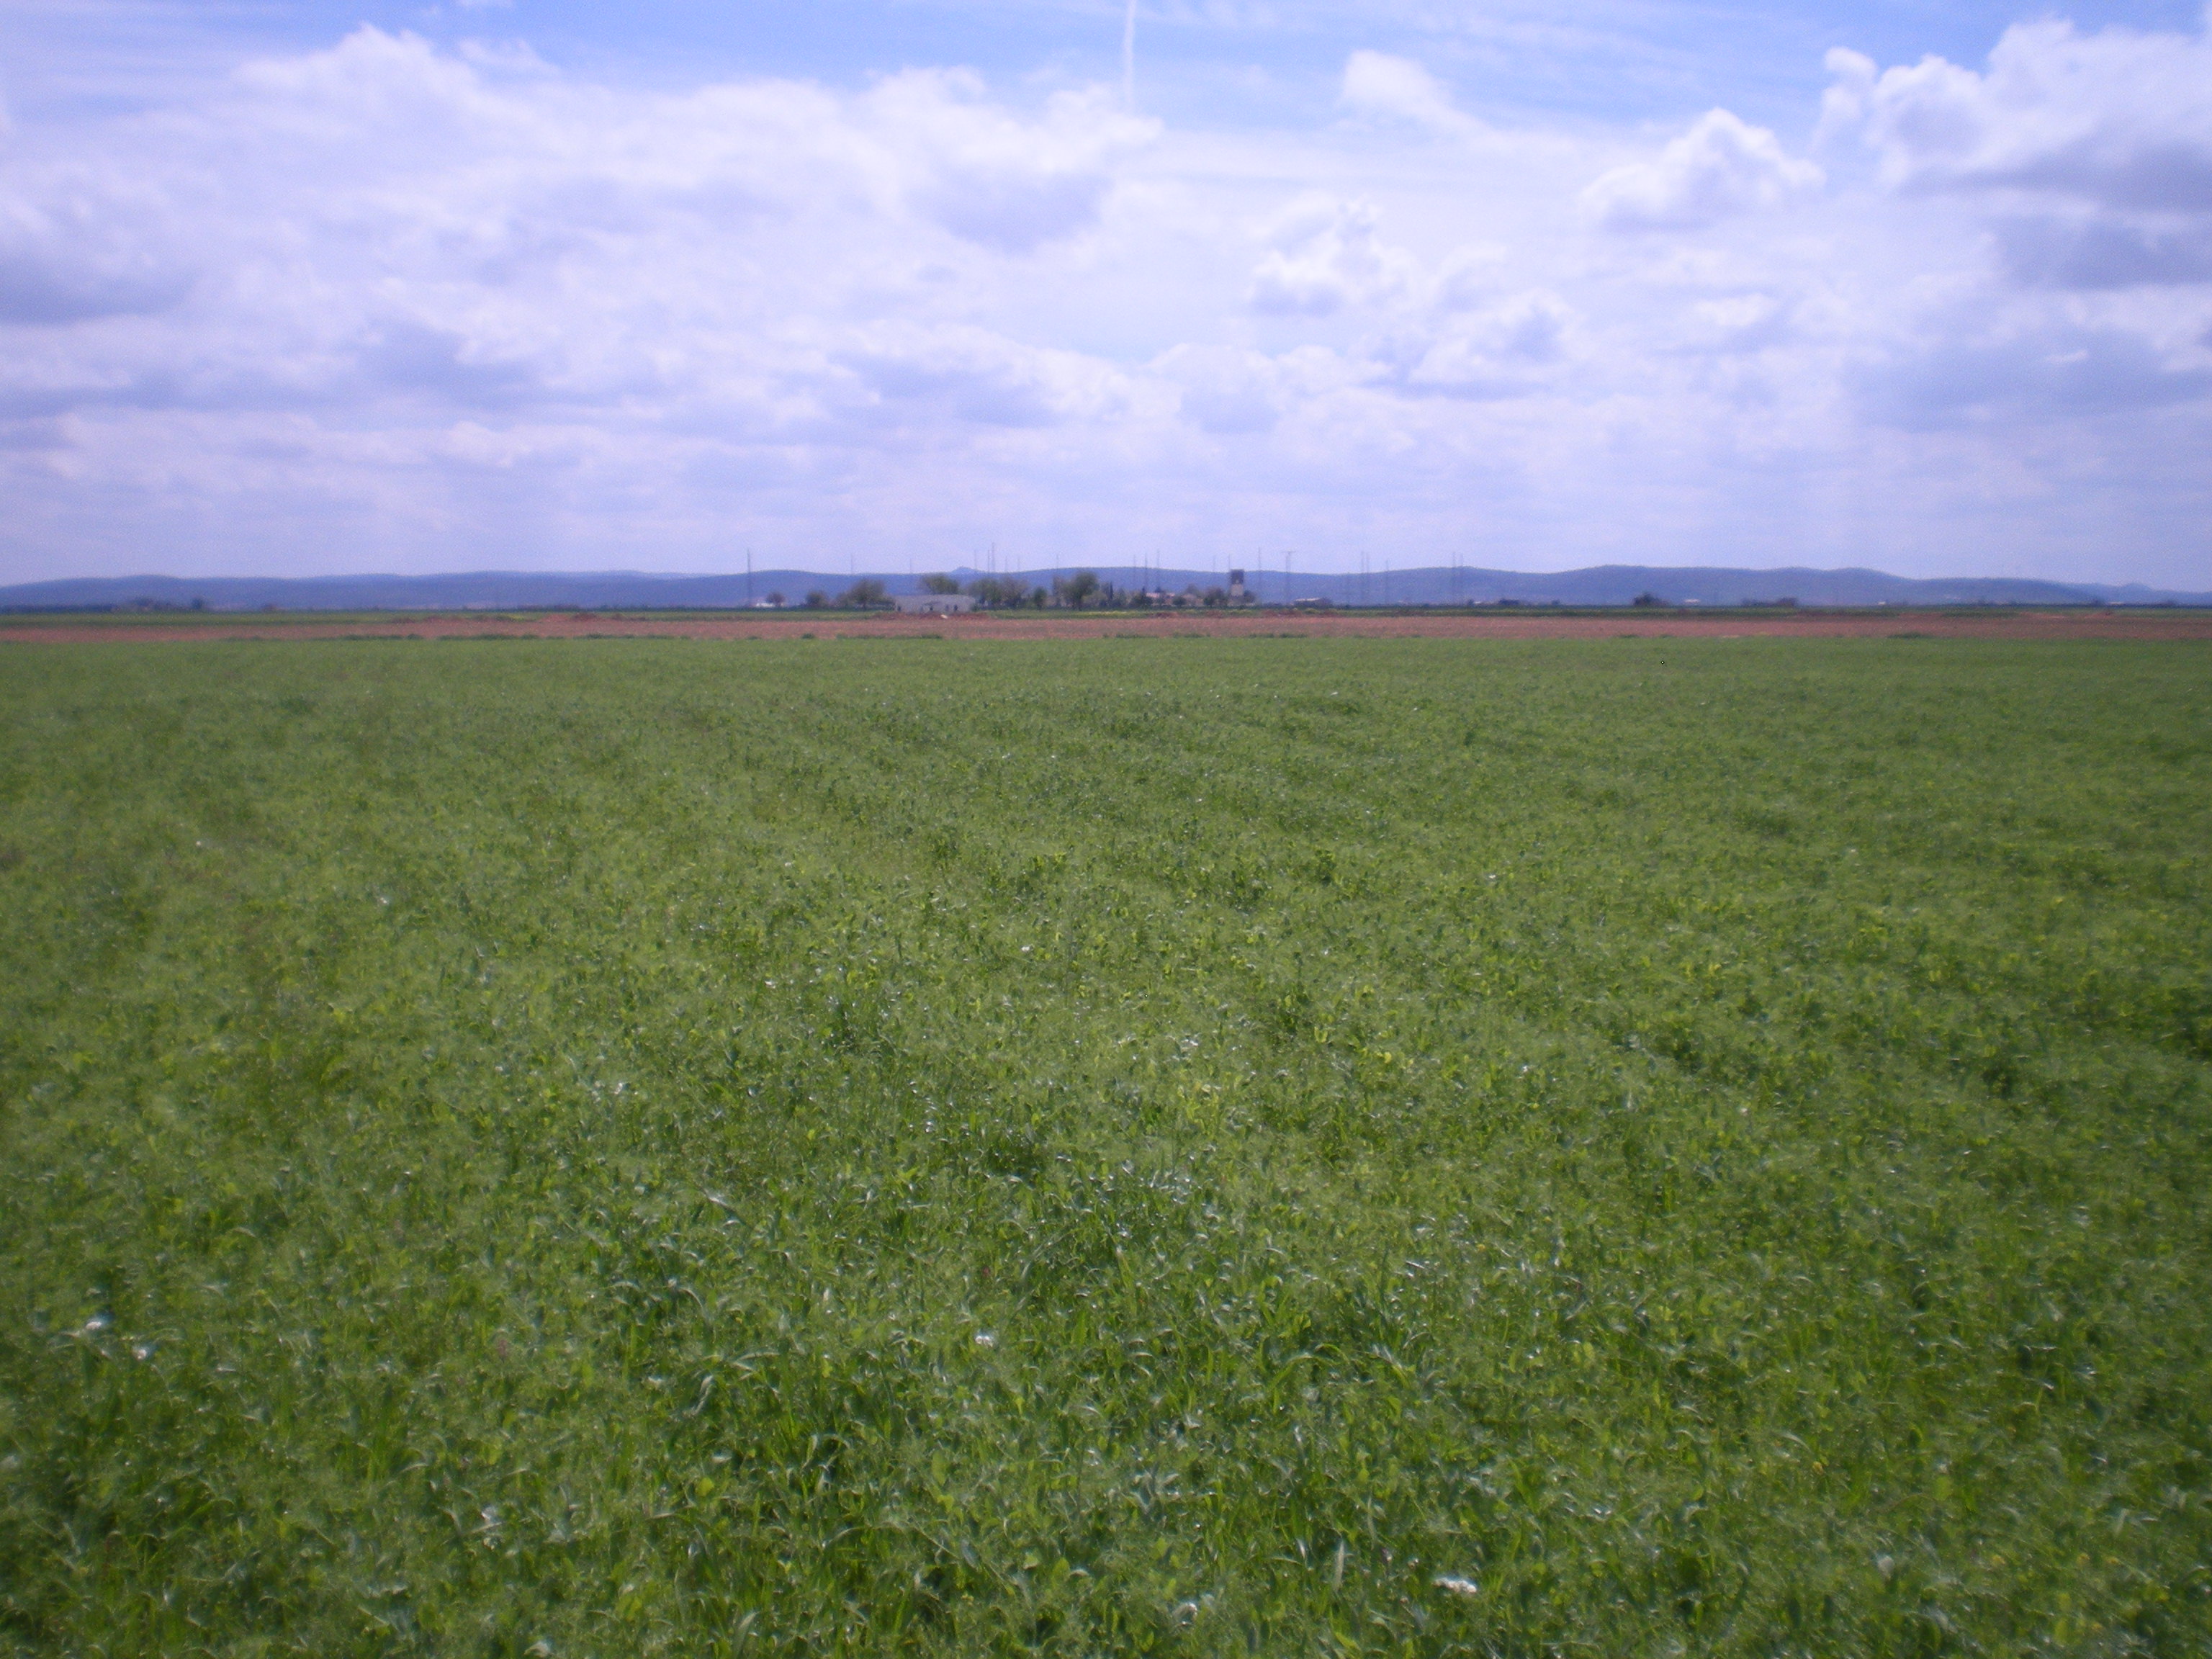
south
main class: Cropland
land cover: Other fresh vegetables
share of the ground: 50 - 75 %
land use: Agriculture (excluding fallow land and kitchen gardens)
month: April
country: ES
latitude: 38.9946
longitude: -3.5361
